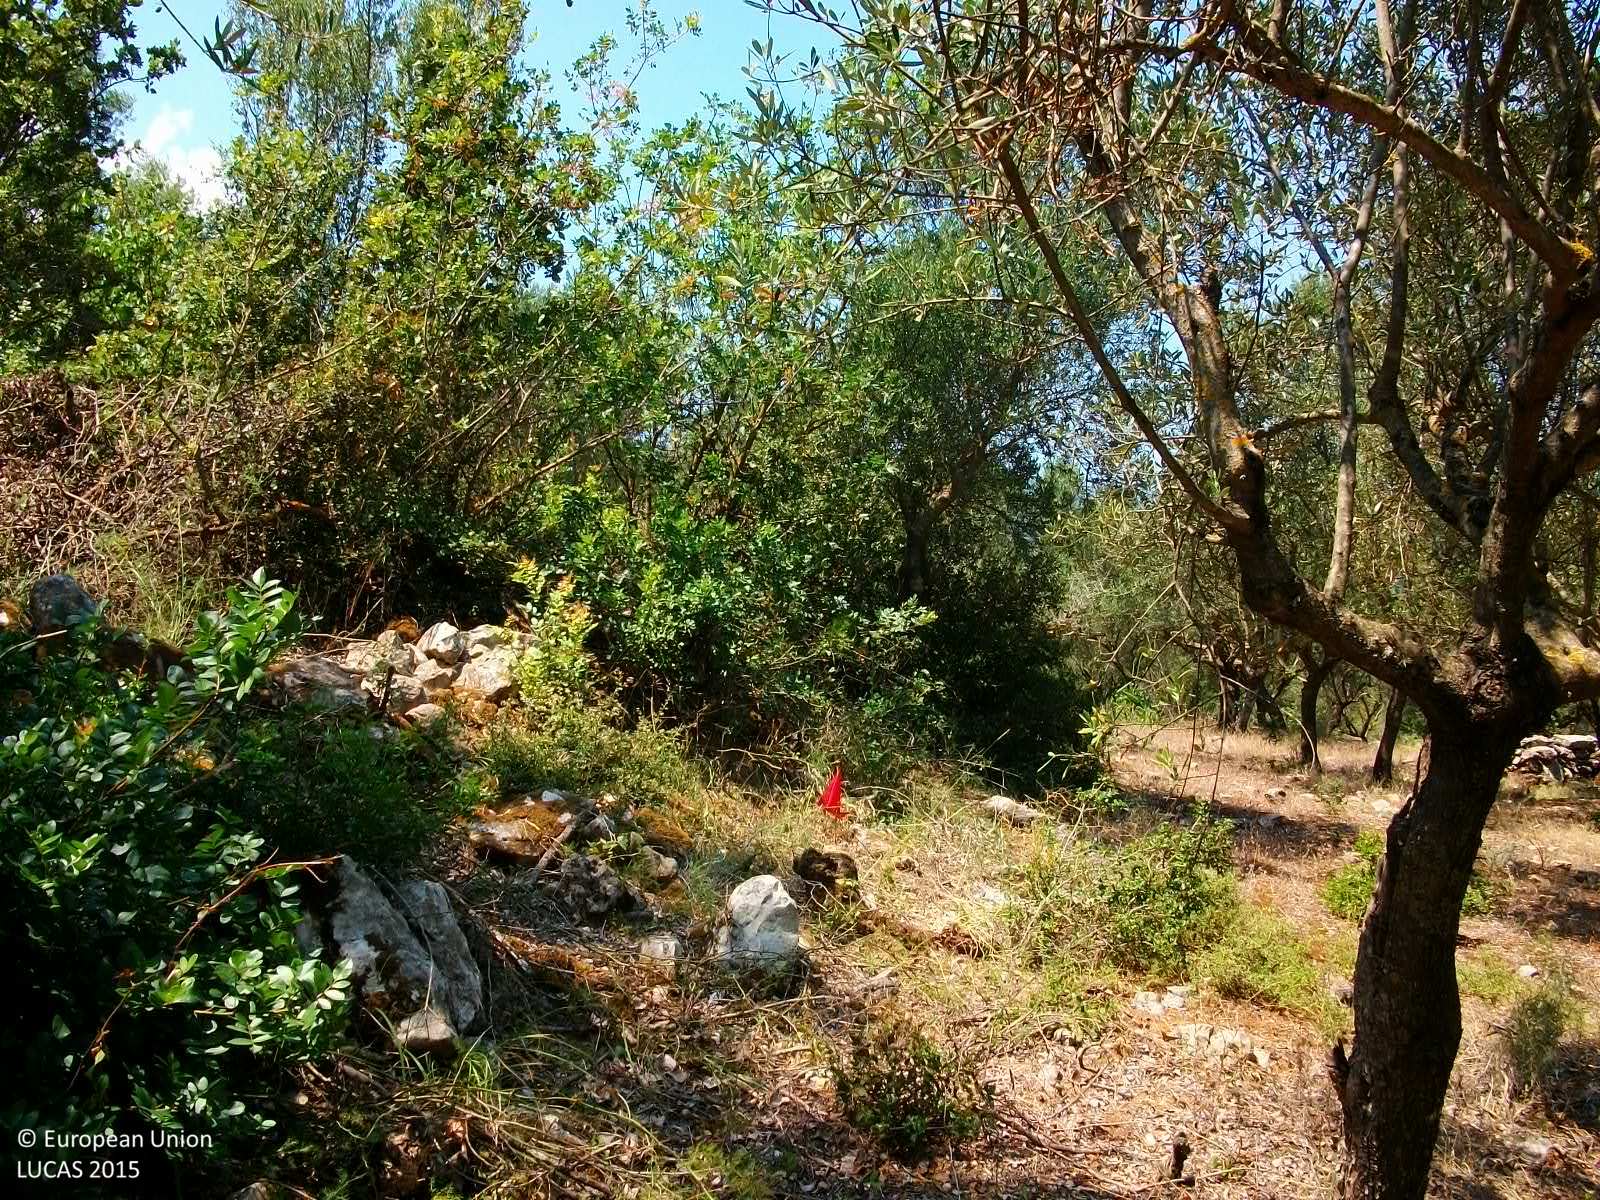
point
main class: Cropland
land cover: Olive groves
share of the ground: 50 - 75 %
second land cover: Spontaneously vegetated surfaces
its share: > 75 %
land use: Agriculture (excluding fallow land and kitchen gardens)
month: July
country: GR
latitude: 37.2309
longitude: 21.9366
